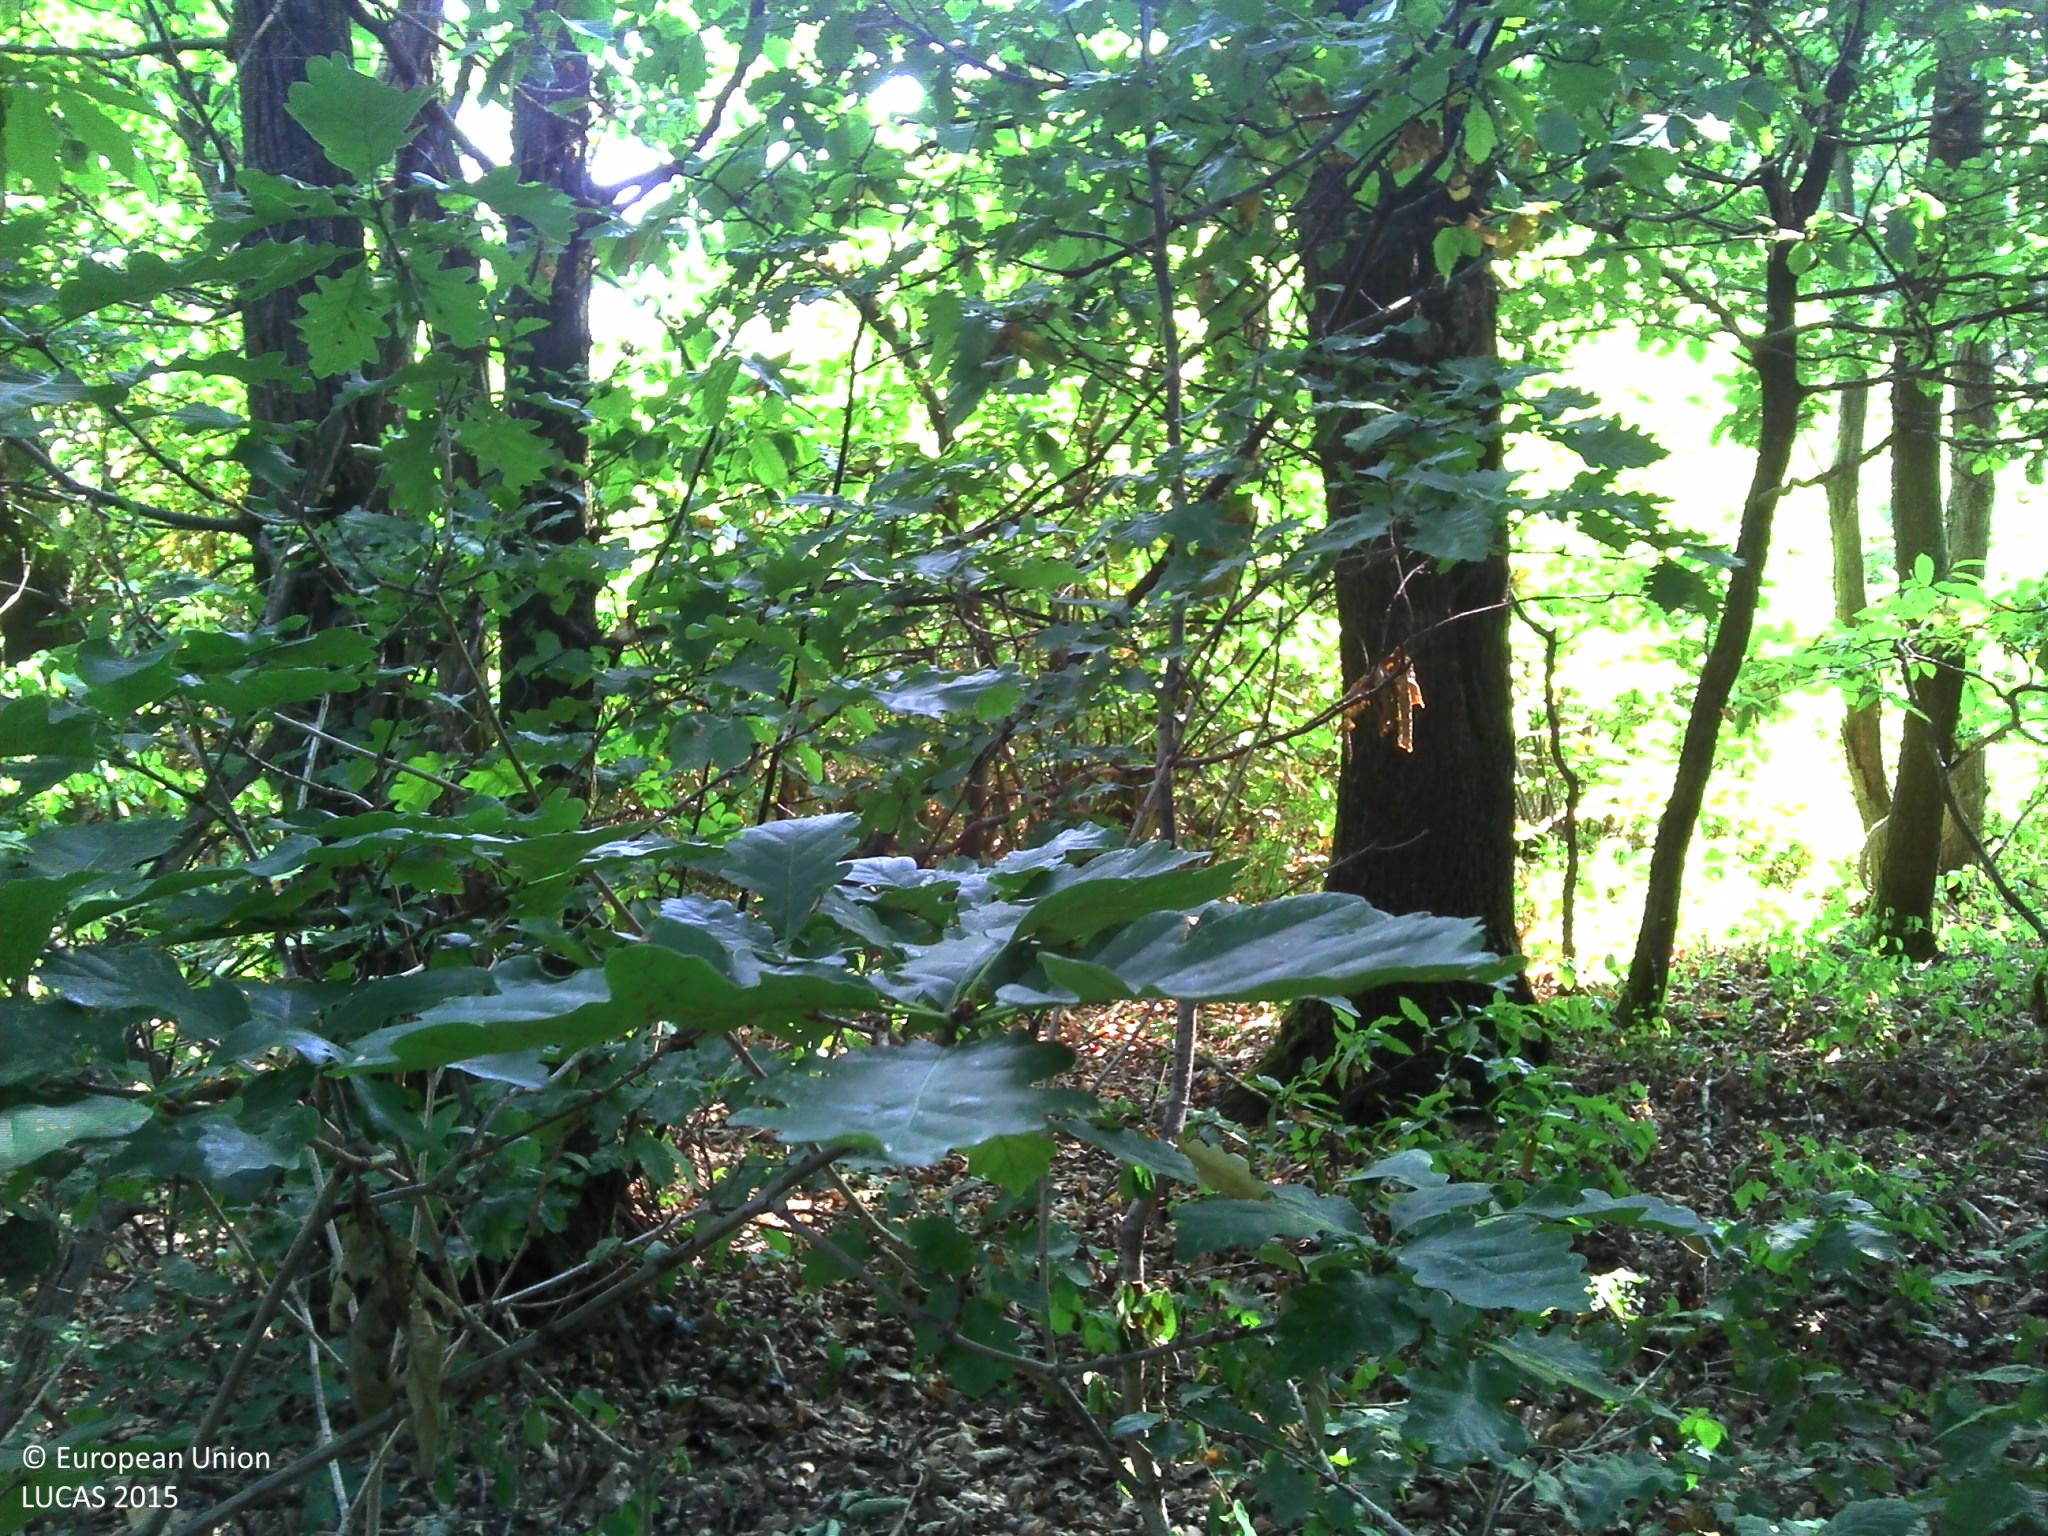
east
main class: Woodland
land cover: Broadleaved woodland
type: mesophytic deciduous forest
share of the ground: > 75 %
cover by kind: broadleaved forest trees 90 %, herbaceous plants 5 %, consolidated bare surface 5 %
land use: Forestry
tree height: > 5 m
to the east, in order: Broadleaved woodland; Shrubland with sparse tree cover; Broadleaved woodland; Grassland with sparse tree/shrub cover; Nuts trees; Grassland with sparse tree/shrub cover; Nuts trees; Broadleaved woodland
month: July
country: FR
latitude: 45.3984
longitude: 4.8819
